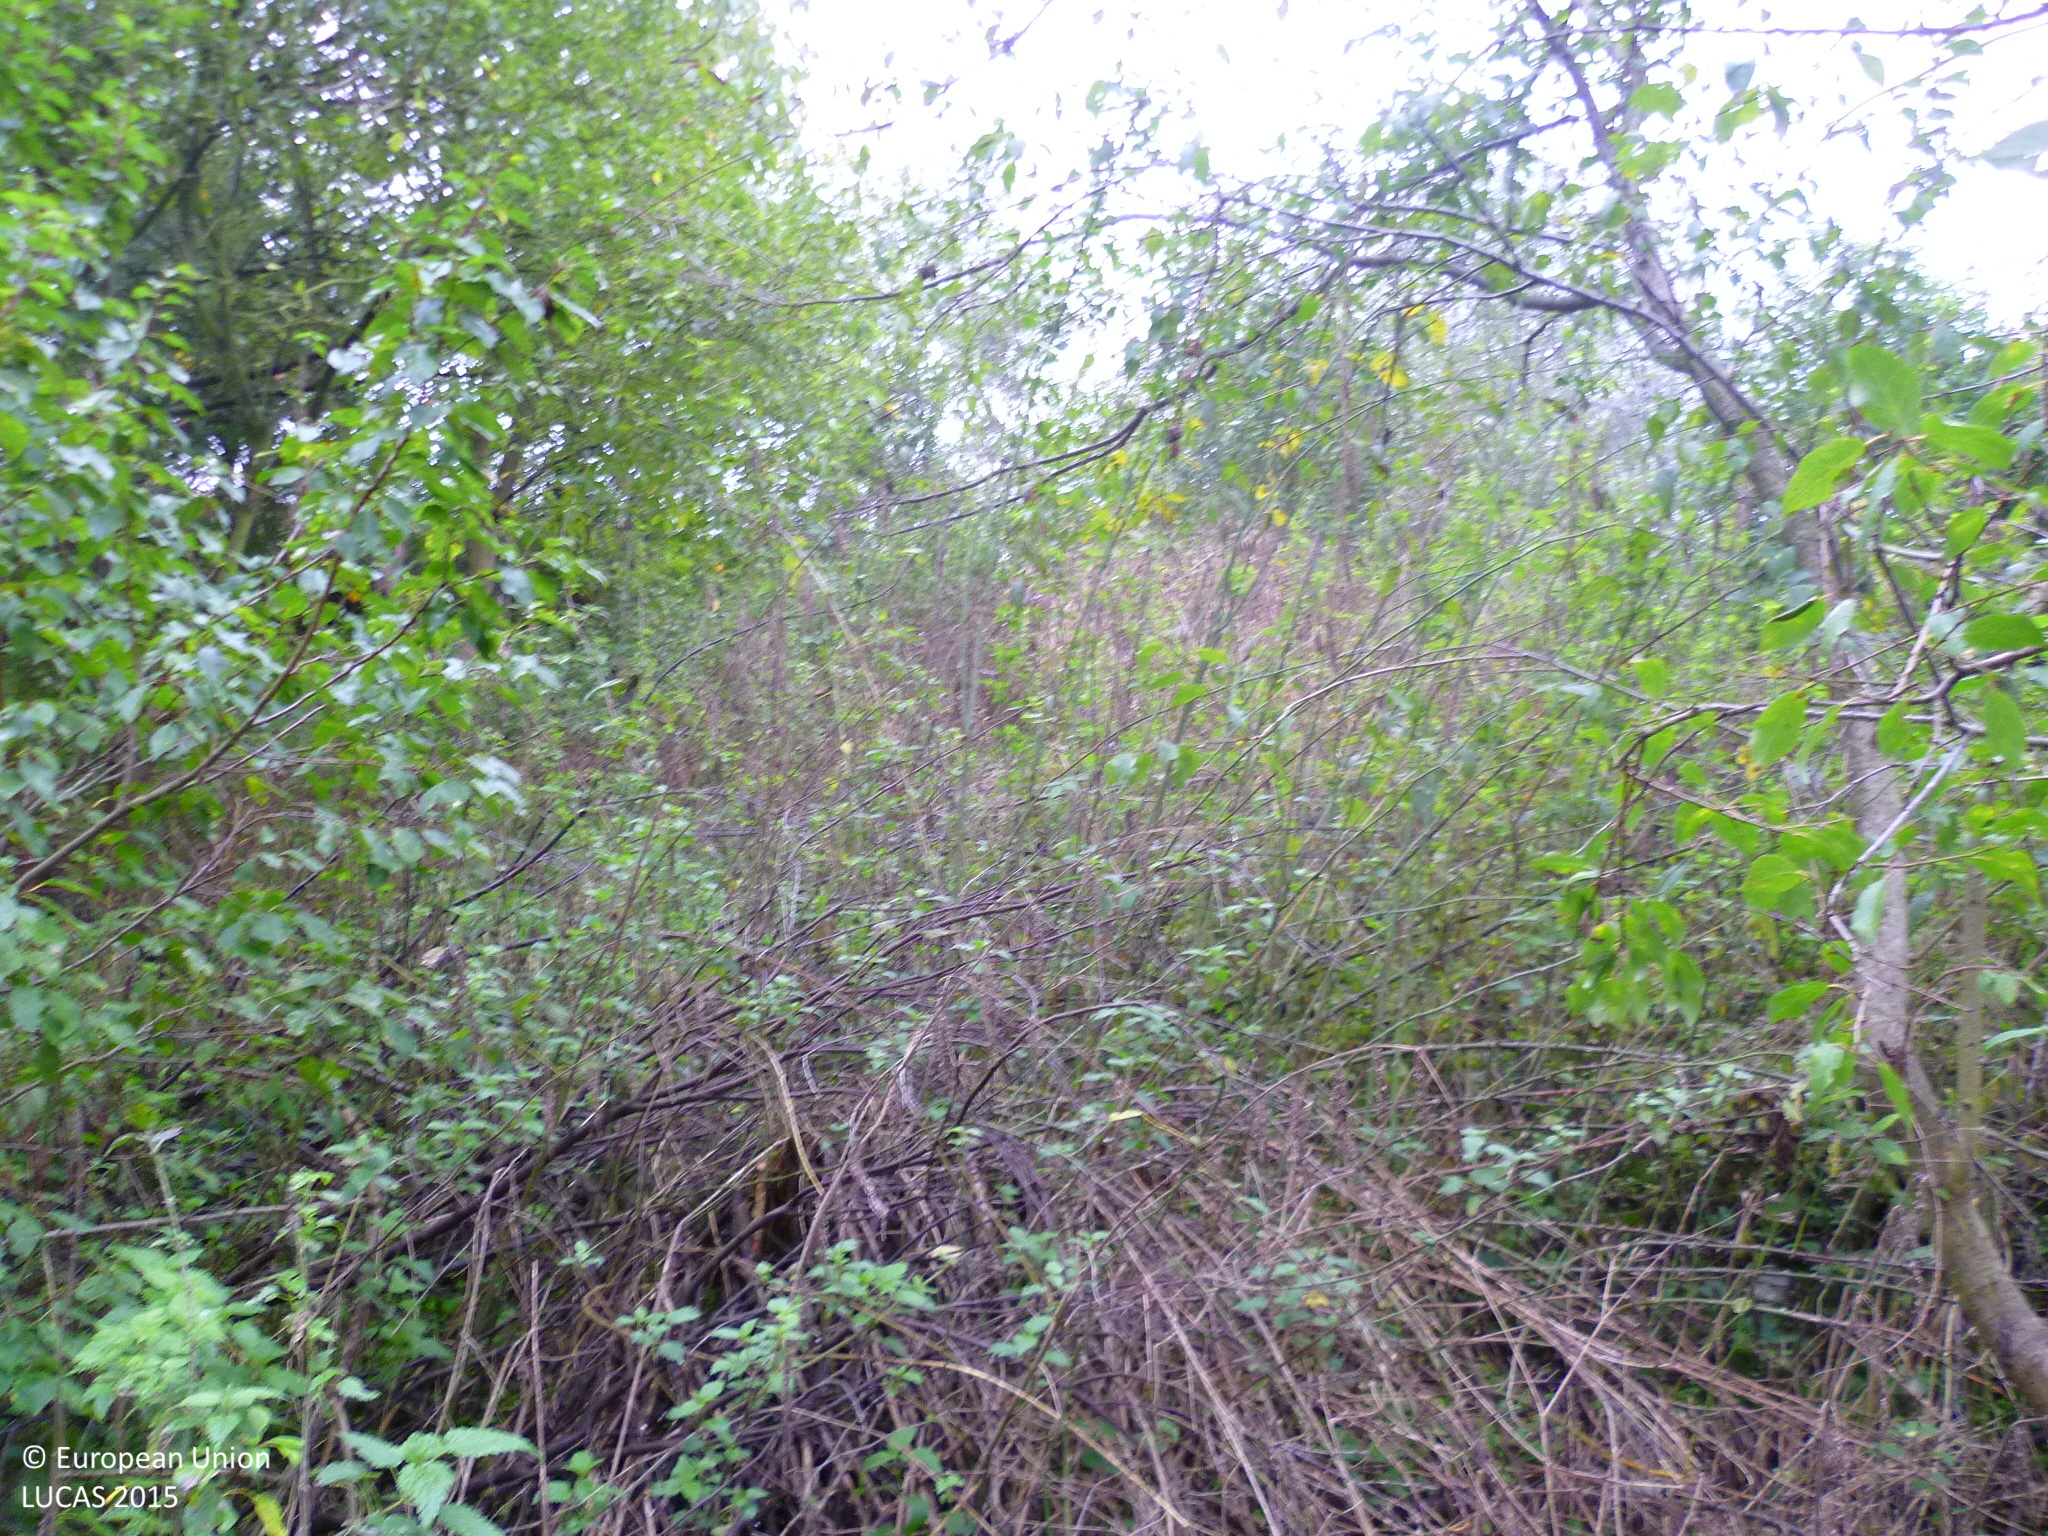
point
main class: Cropland
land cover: Pear fruit
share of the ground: 10 - 25 %
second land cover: Shrubland without tree cover
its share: 50 - 75 %
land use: Abandoned areas
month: October
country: BG
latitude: 42.3963
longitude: 23.5559
